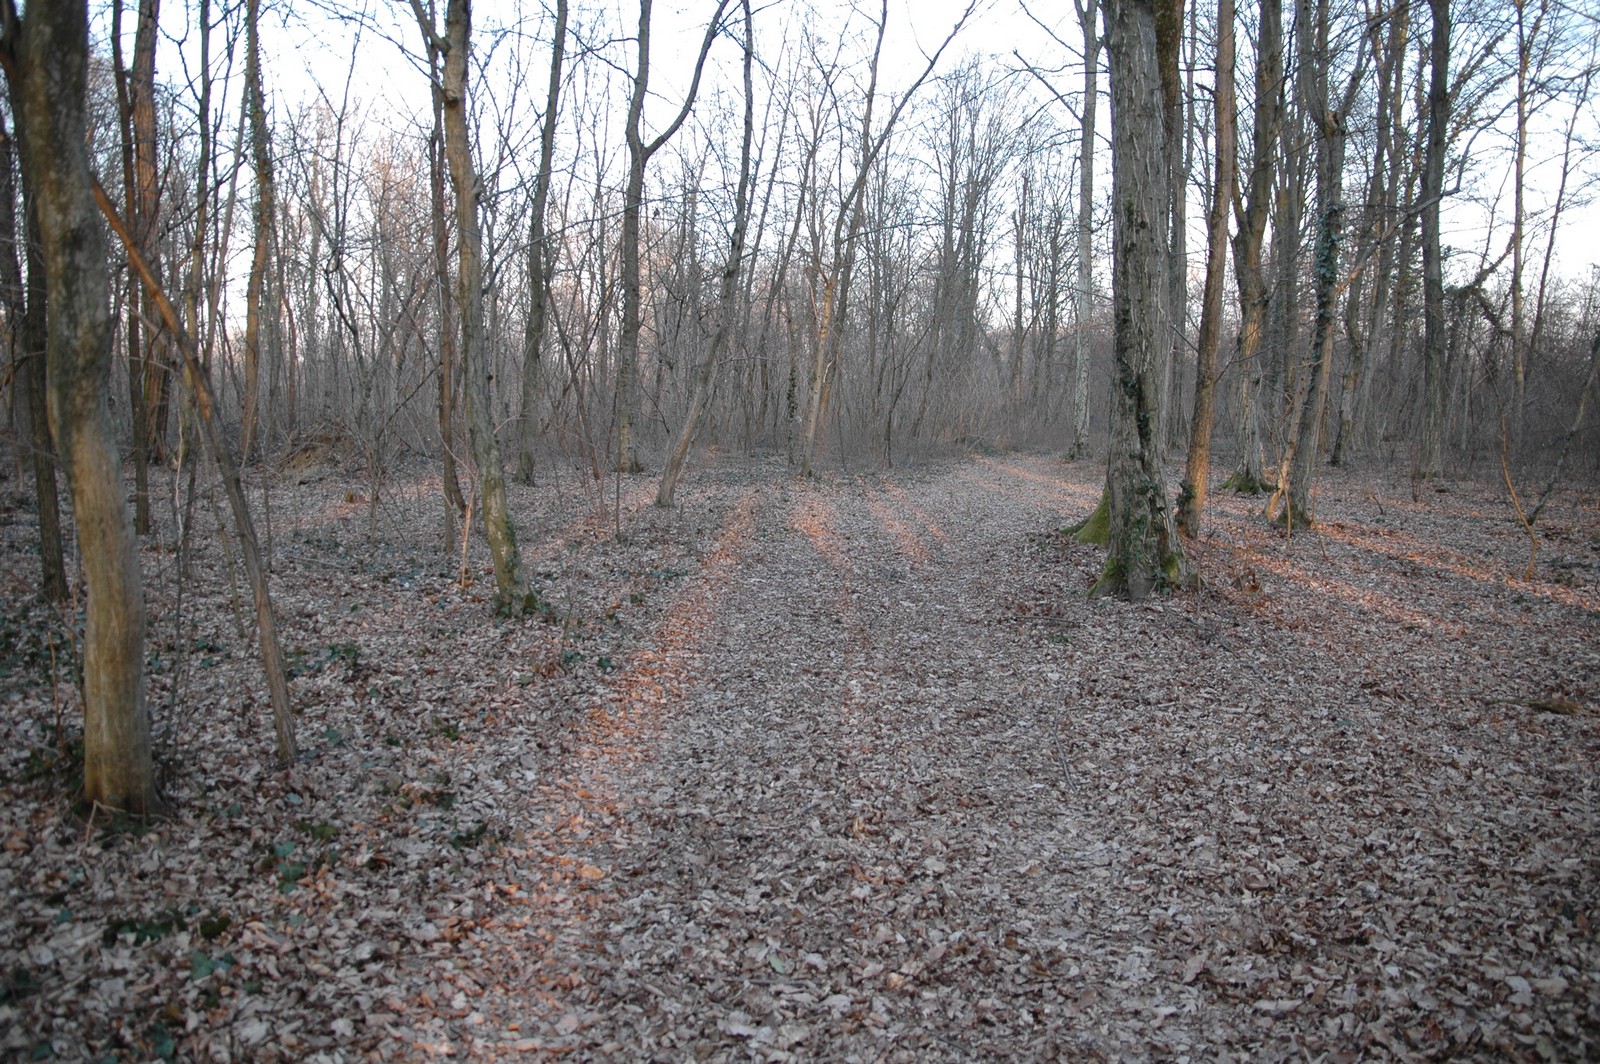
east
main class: Woodland
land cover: Broadleaved woodland
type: mesophytic deciduous forest
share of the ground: > 75 %
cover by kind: broadleaved forest trees 90 %, shrubs 5 %, herbaceous plants 5 %
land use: Forestry
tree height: > 5 m
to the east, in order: Broadleaved woodland
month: March
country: HR
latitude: 46.3730
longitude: 16.1488
